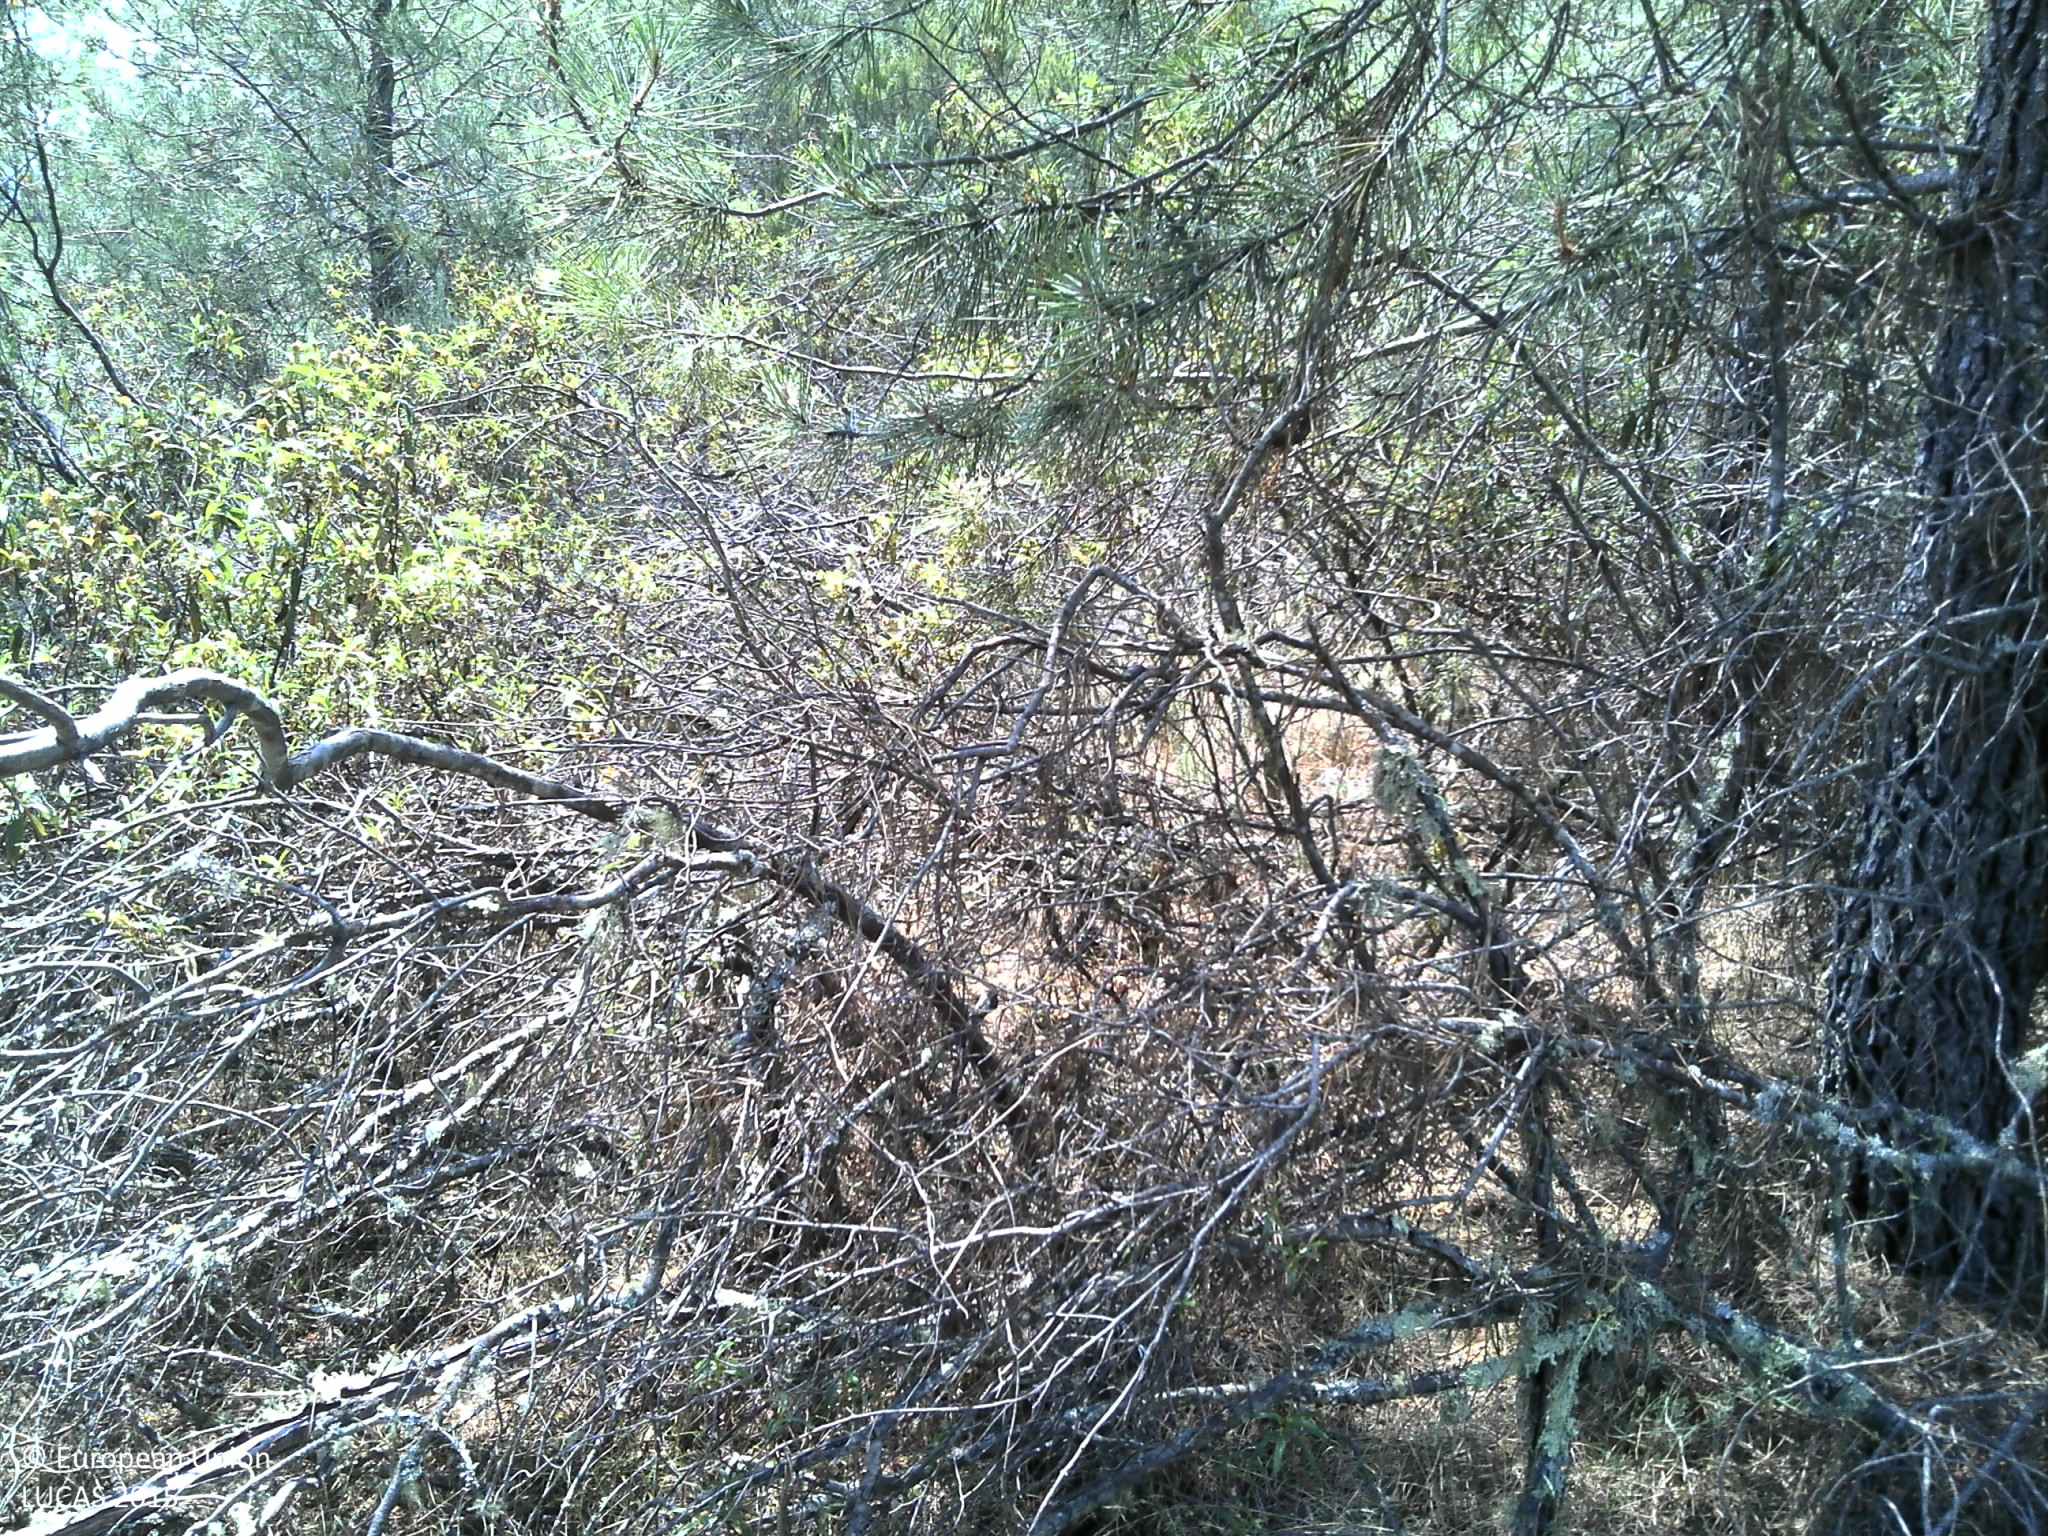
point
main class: Woodland
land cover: Pine dominated coniferous woodland
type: coniferous forest of the mediterranean region
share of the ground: 10 - 25 %
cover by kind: shrubs 80 %, coniferous forest trees 20 %
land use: Forestry
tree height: > 5 m
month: June
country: PT
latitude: 41.1879
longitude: -7.6155
